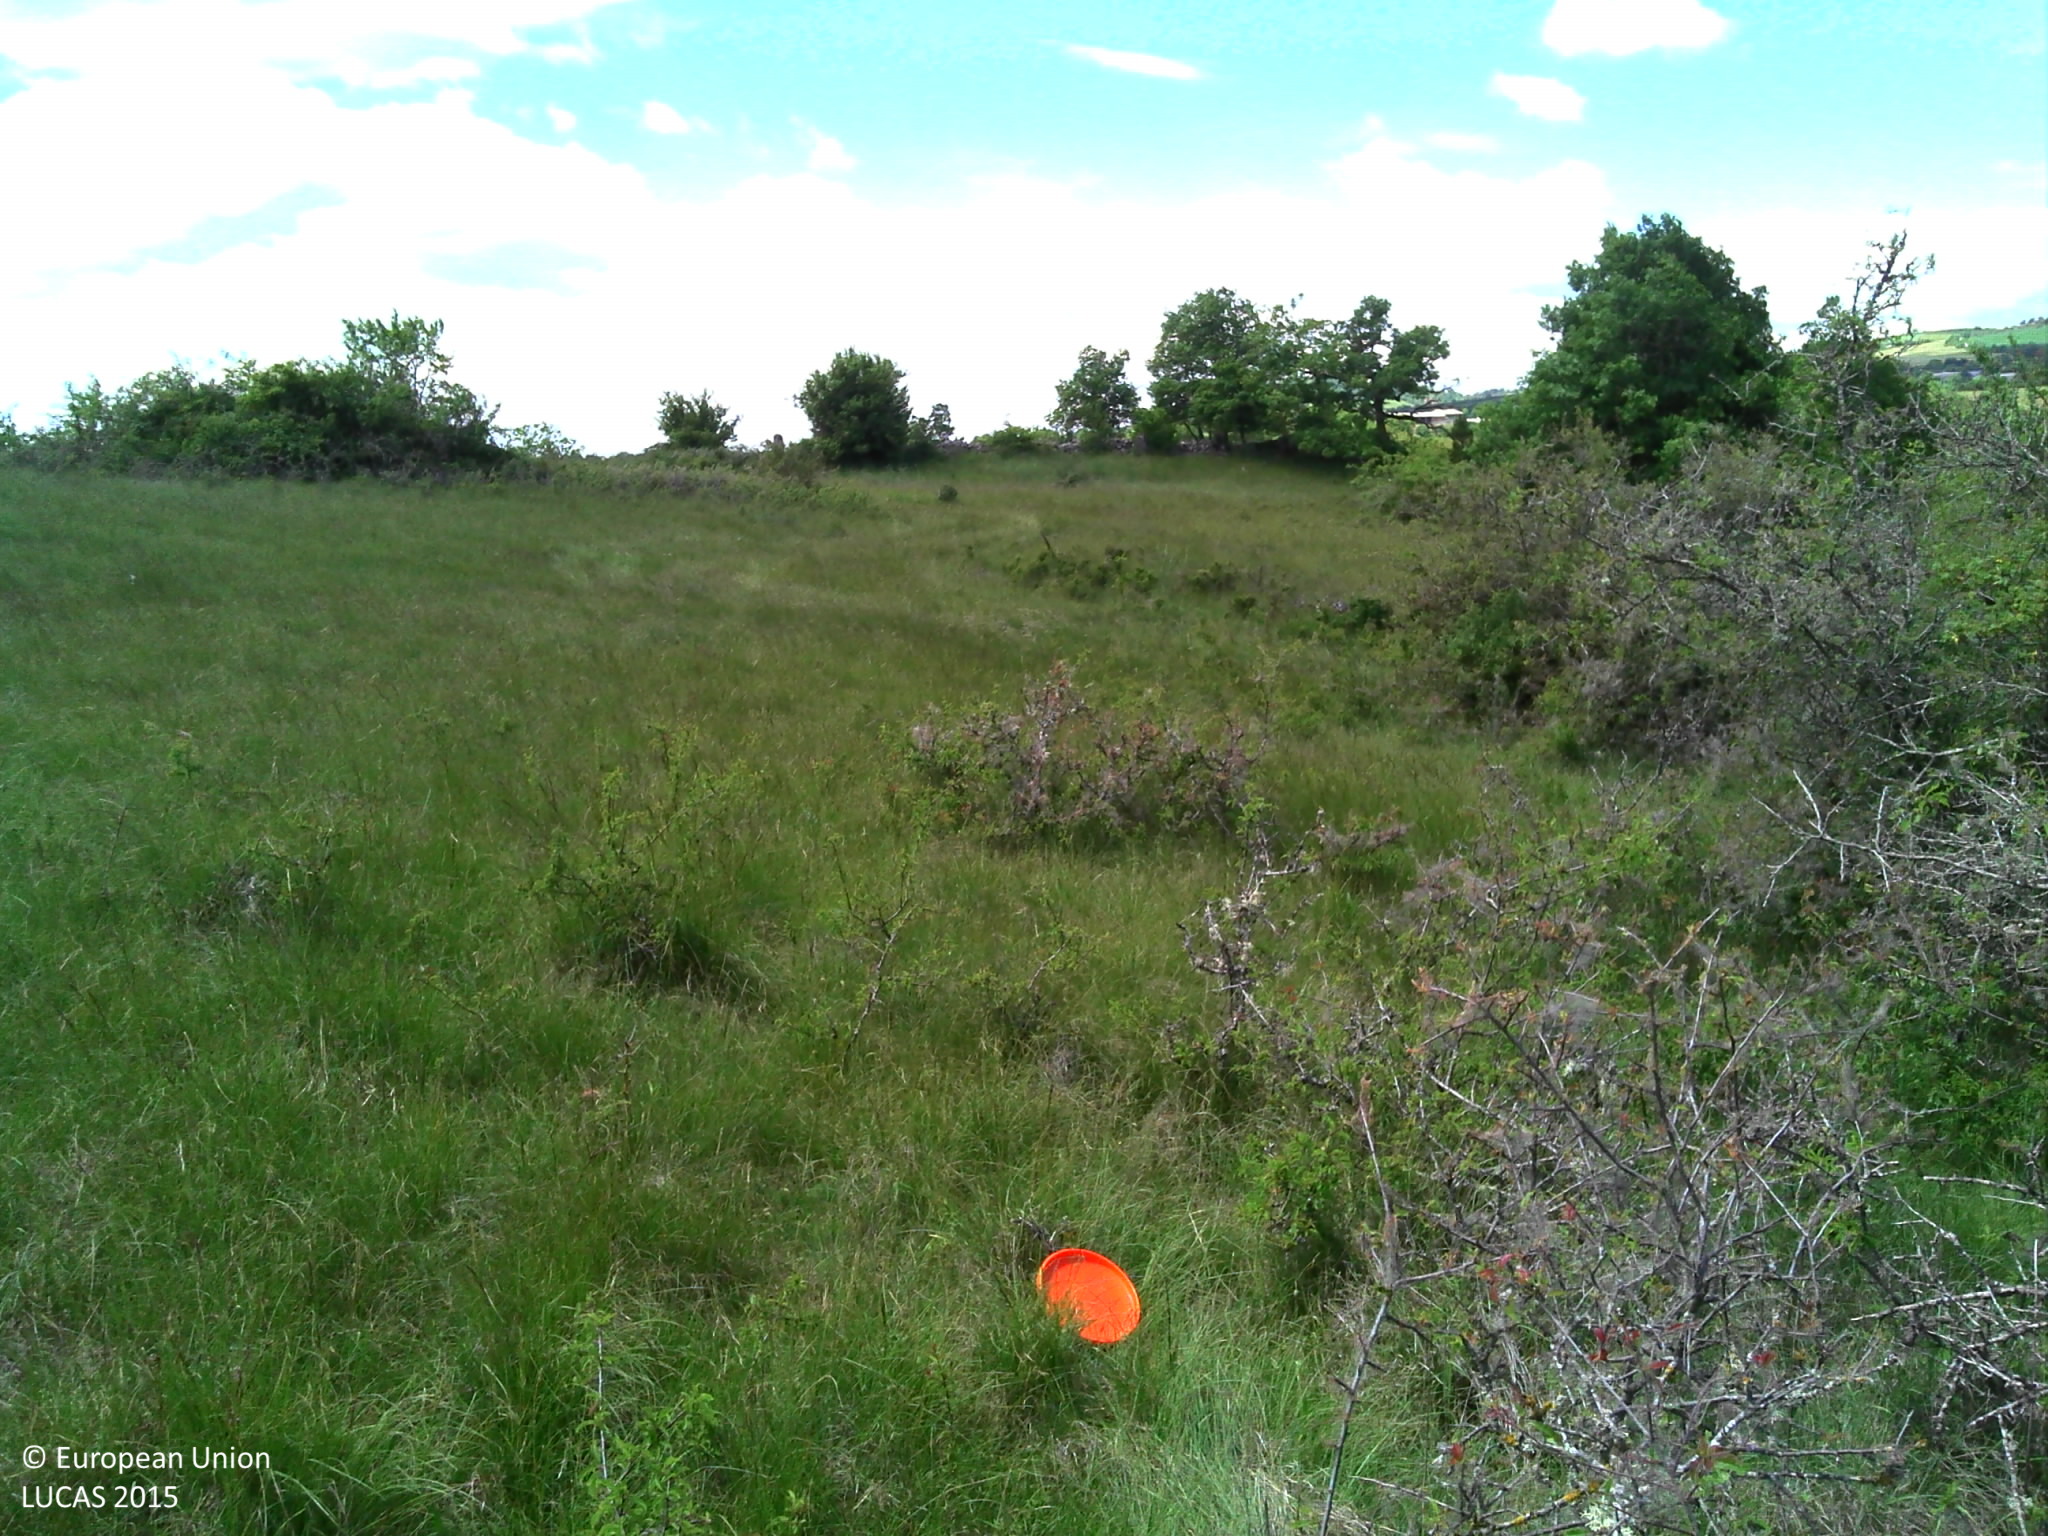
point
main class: Grassland
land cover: Grassland with sparse tree/shrub cover
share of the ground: > 75 %
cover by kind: herbaceous plants 85 %, shrubs 10 %, coniferous forest trees 5 %
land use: Agriculture (excluding fallow land and kitchen gardens)
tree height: < 5 m
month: May
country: FR
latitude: 44.3359
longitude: 3.0693
